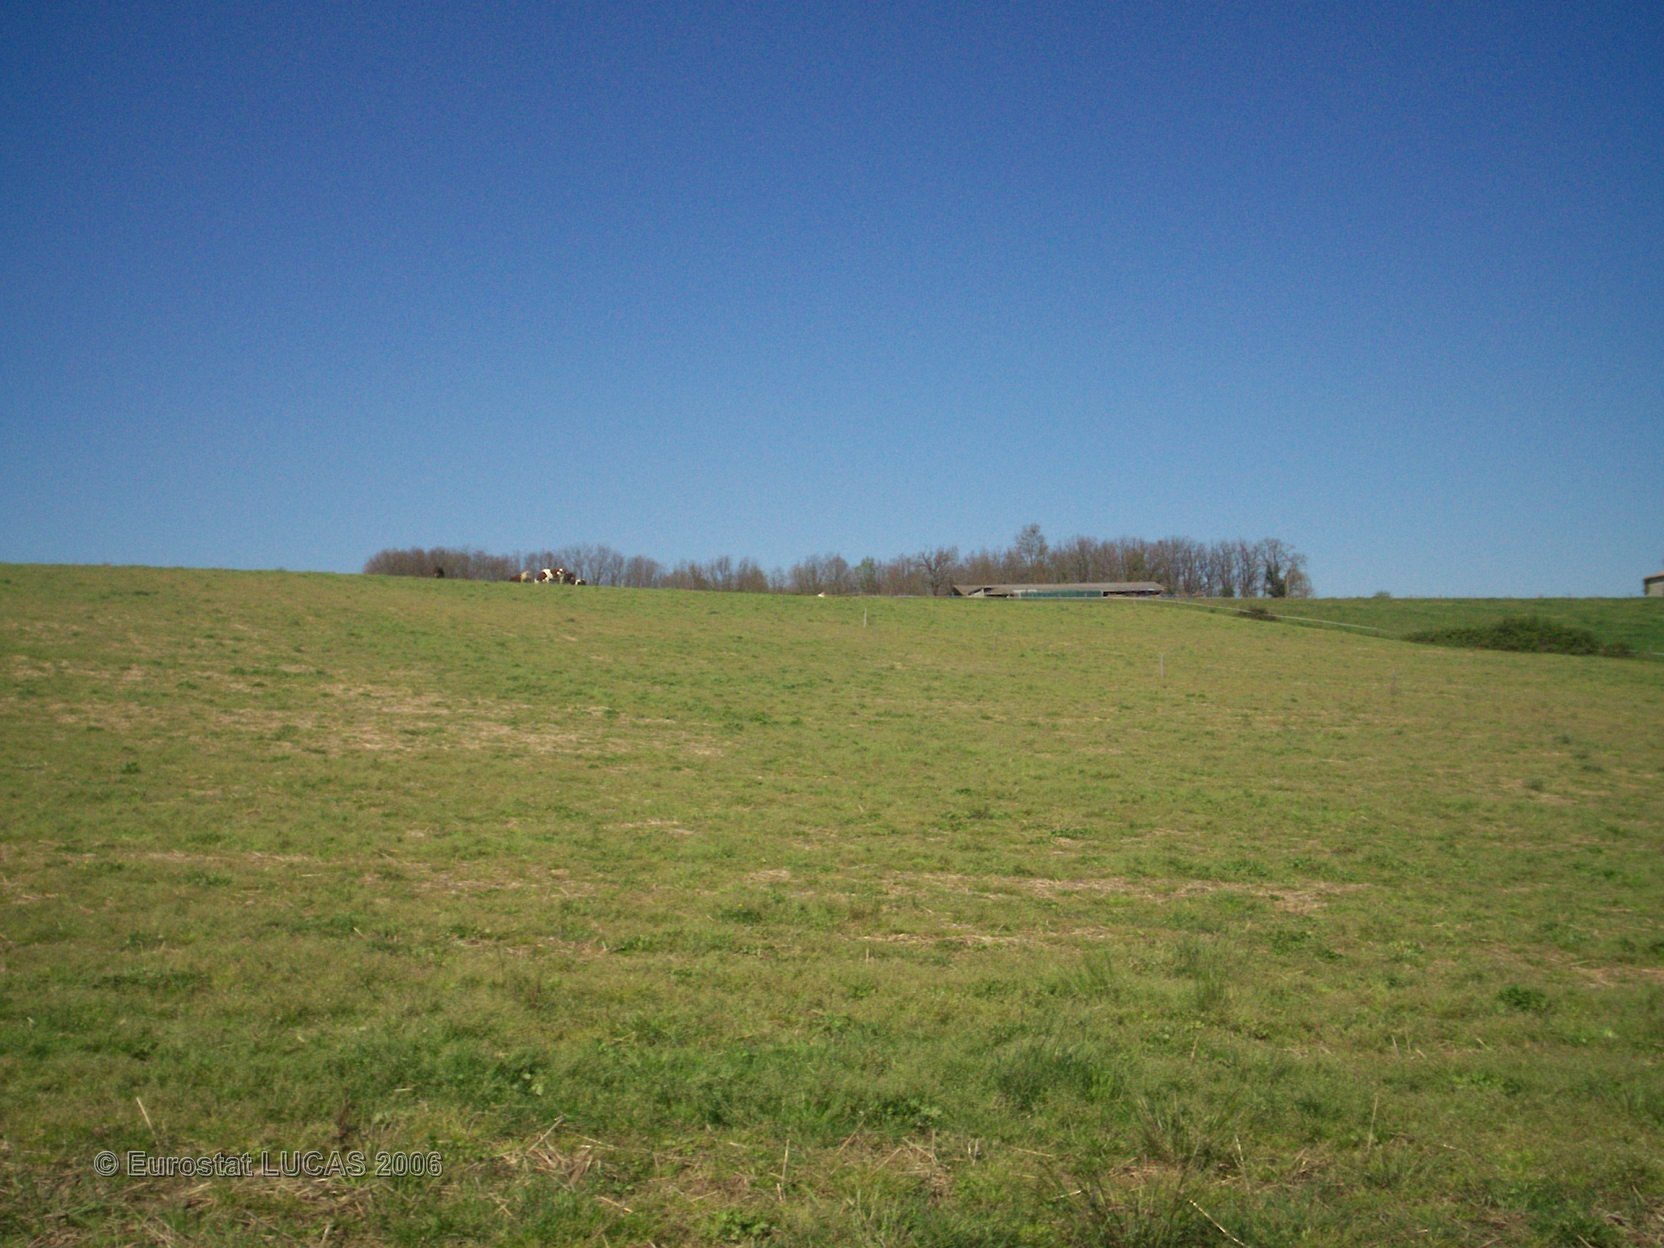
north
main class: Grassland
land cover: Grassland without tree/shrub cover
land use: Agriculture (excluding fallow land and kitchen gardens)
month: April
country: FR
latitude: 44.0250
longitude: 0.9274
